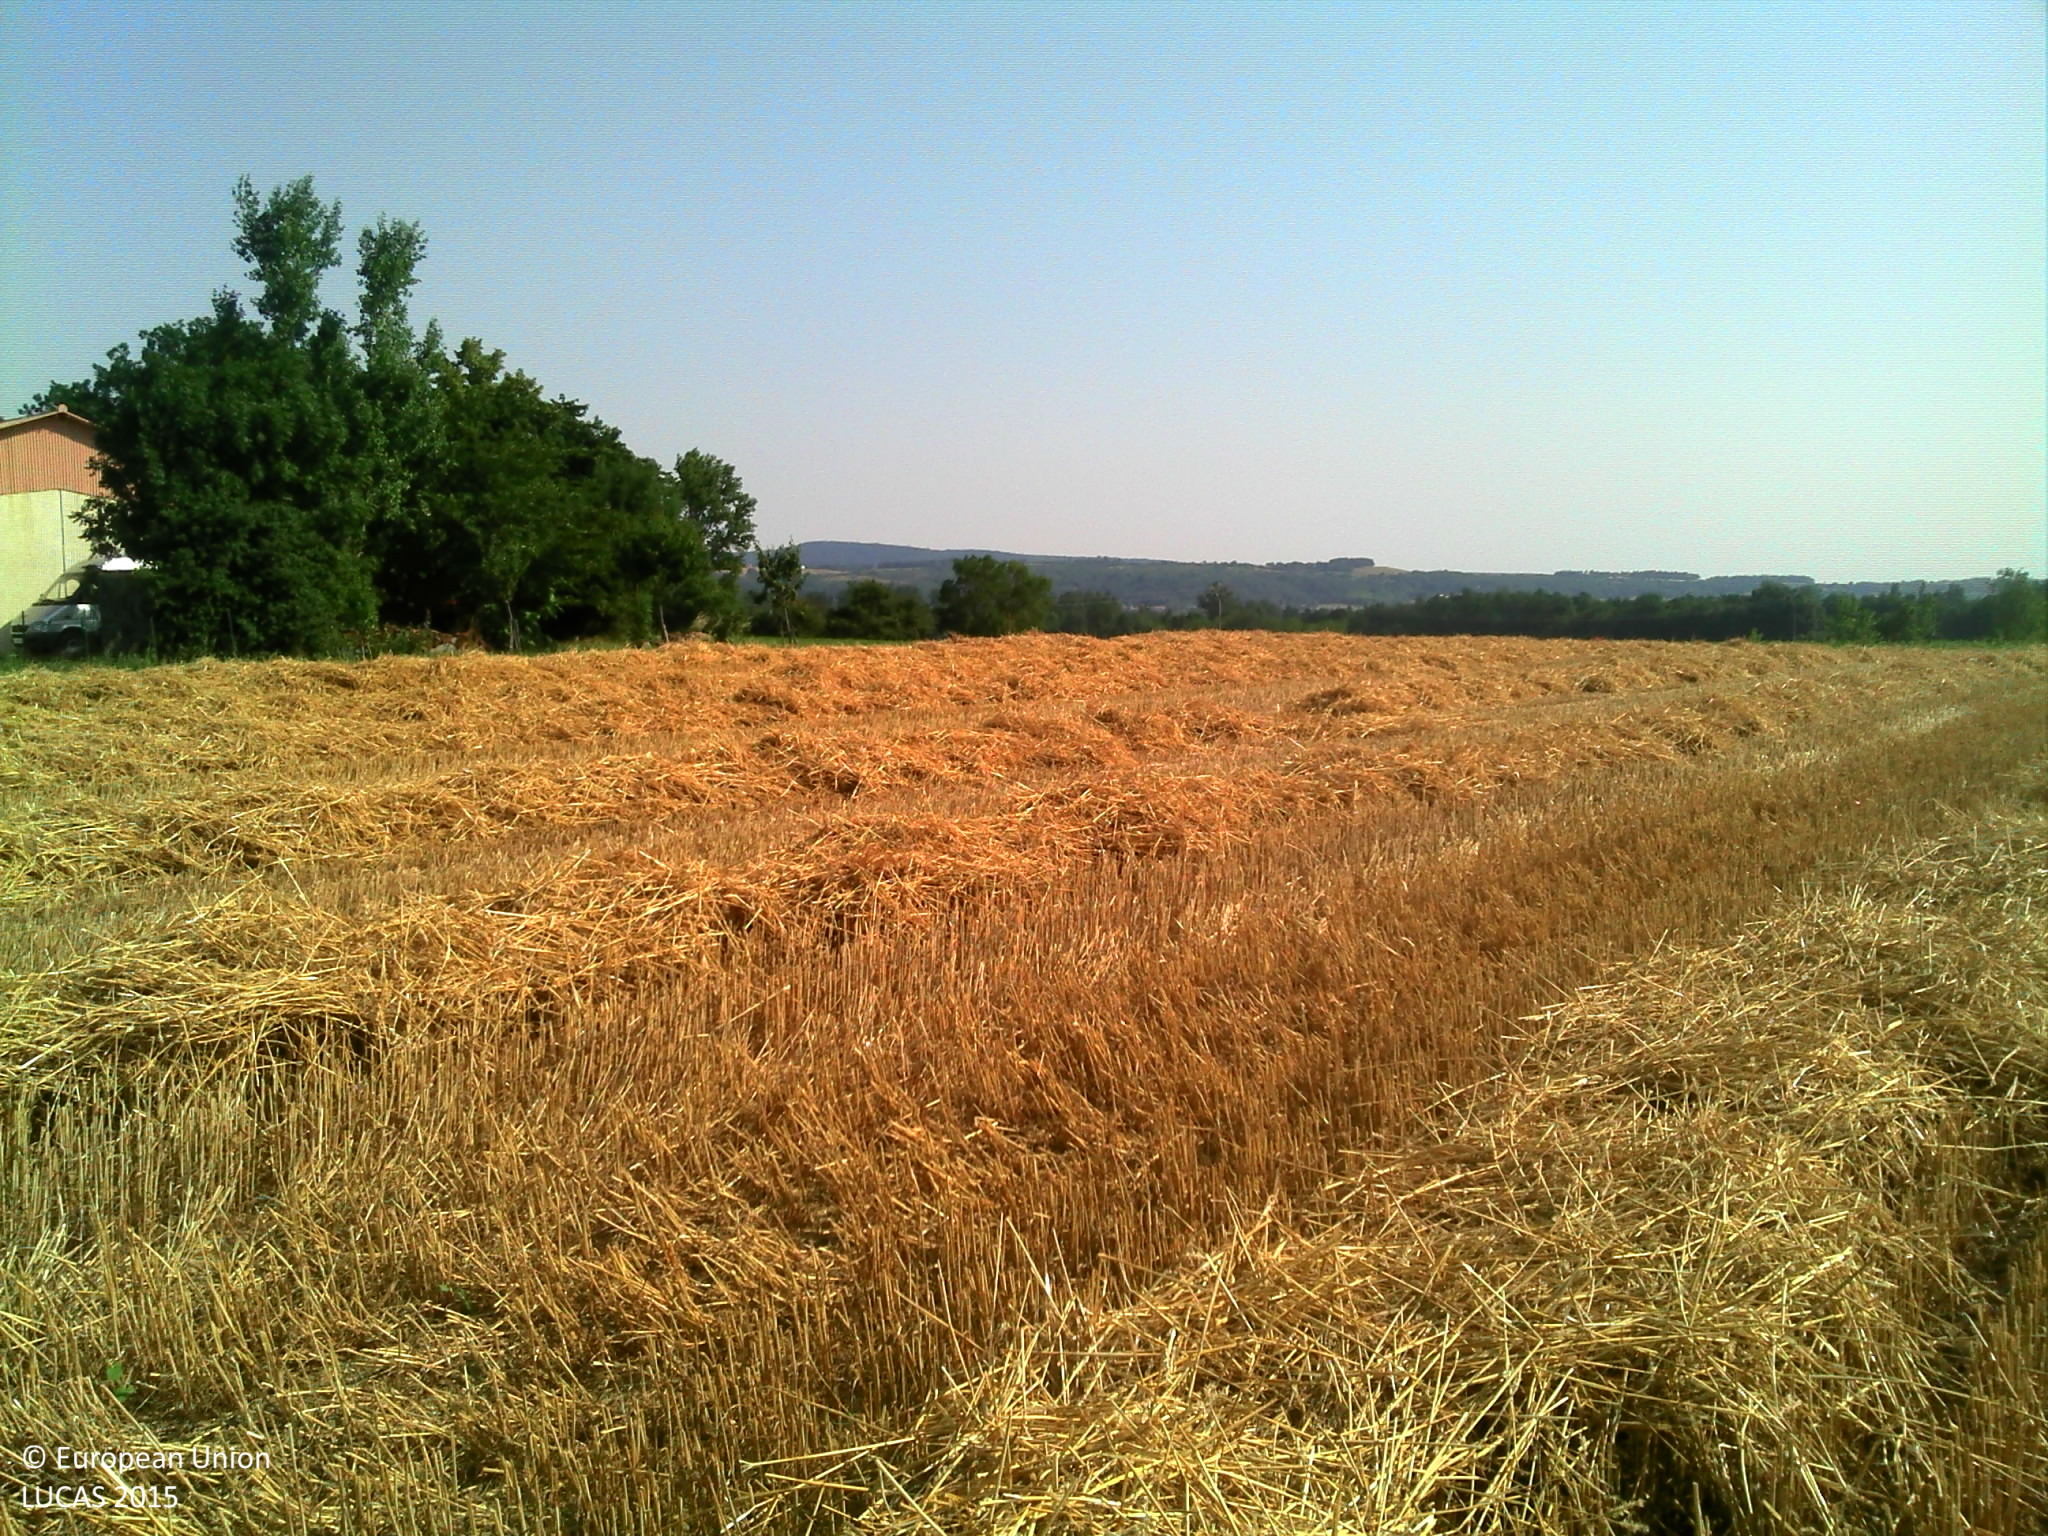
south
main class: Cropland
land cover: Common wheat
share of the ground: > 75 %
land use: Agriculture (excluding fallow land and kitchen gardens)
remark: Harvested field
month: July
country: FR
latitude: 43.4801
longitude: 2.0064
